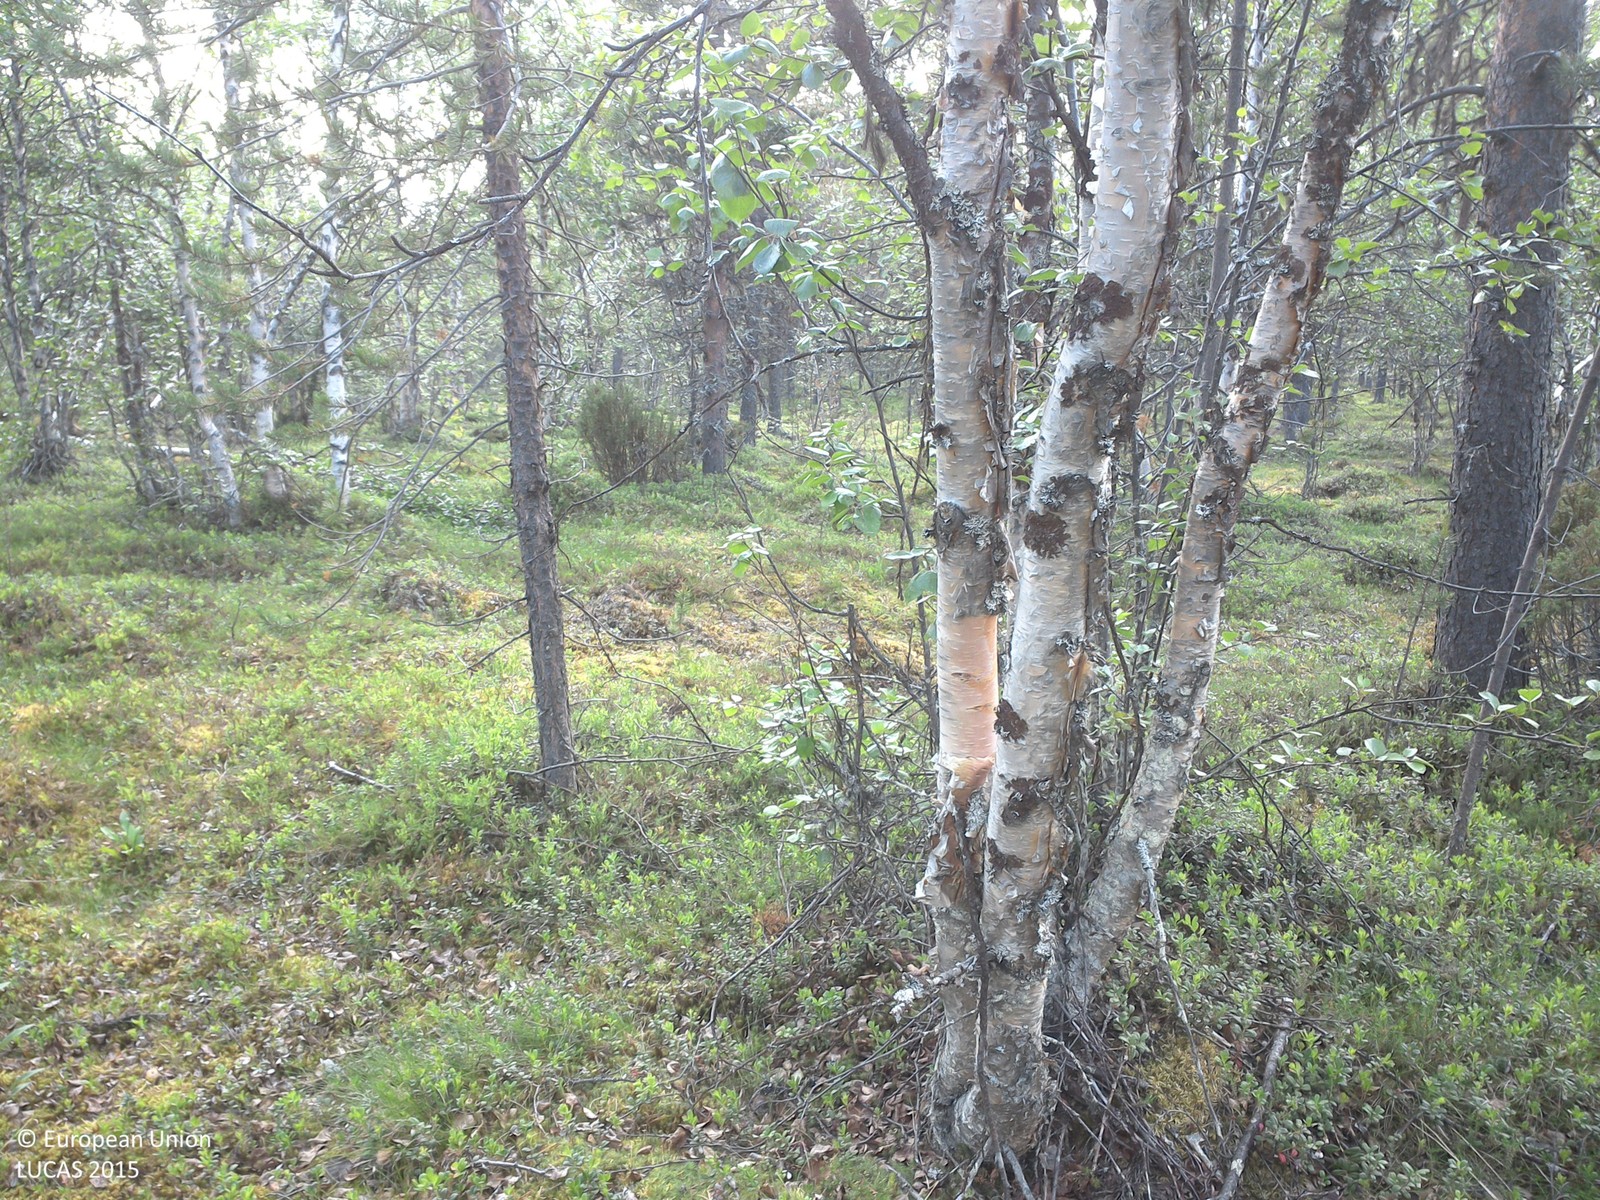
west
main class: Woodland
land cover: Pine dominated mixed woodland
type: boreal forest
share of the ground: 25 - 50 %
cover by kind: shrubs 55 %, coniferous forest trees 20 %, broadleaved forest trees 15 %, lichens and mosses 10 %
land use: Forestry
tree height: > 5 m
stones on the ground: < 10 %
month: July
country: SE
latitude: 67.8480
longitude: 22.2848
